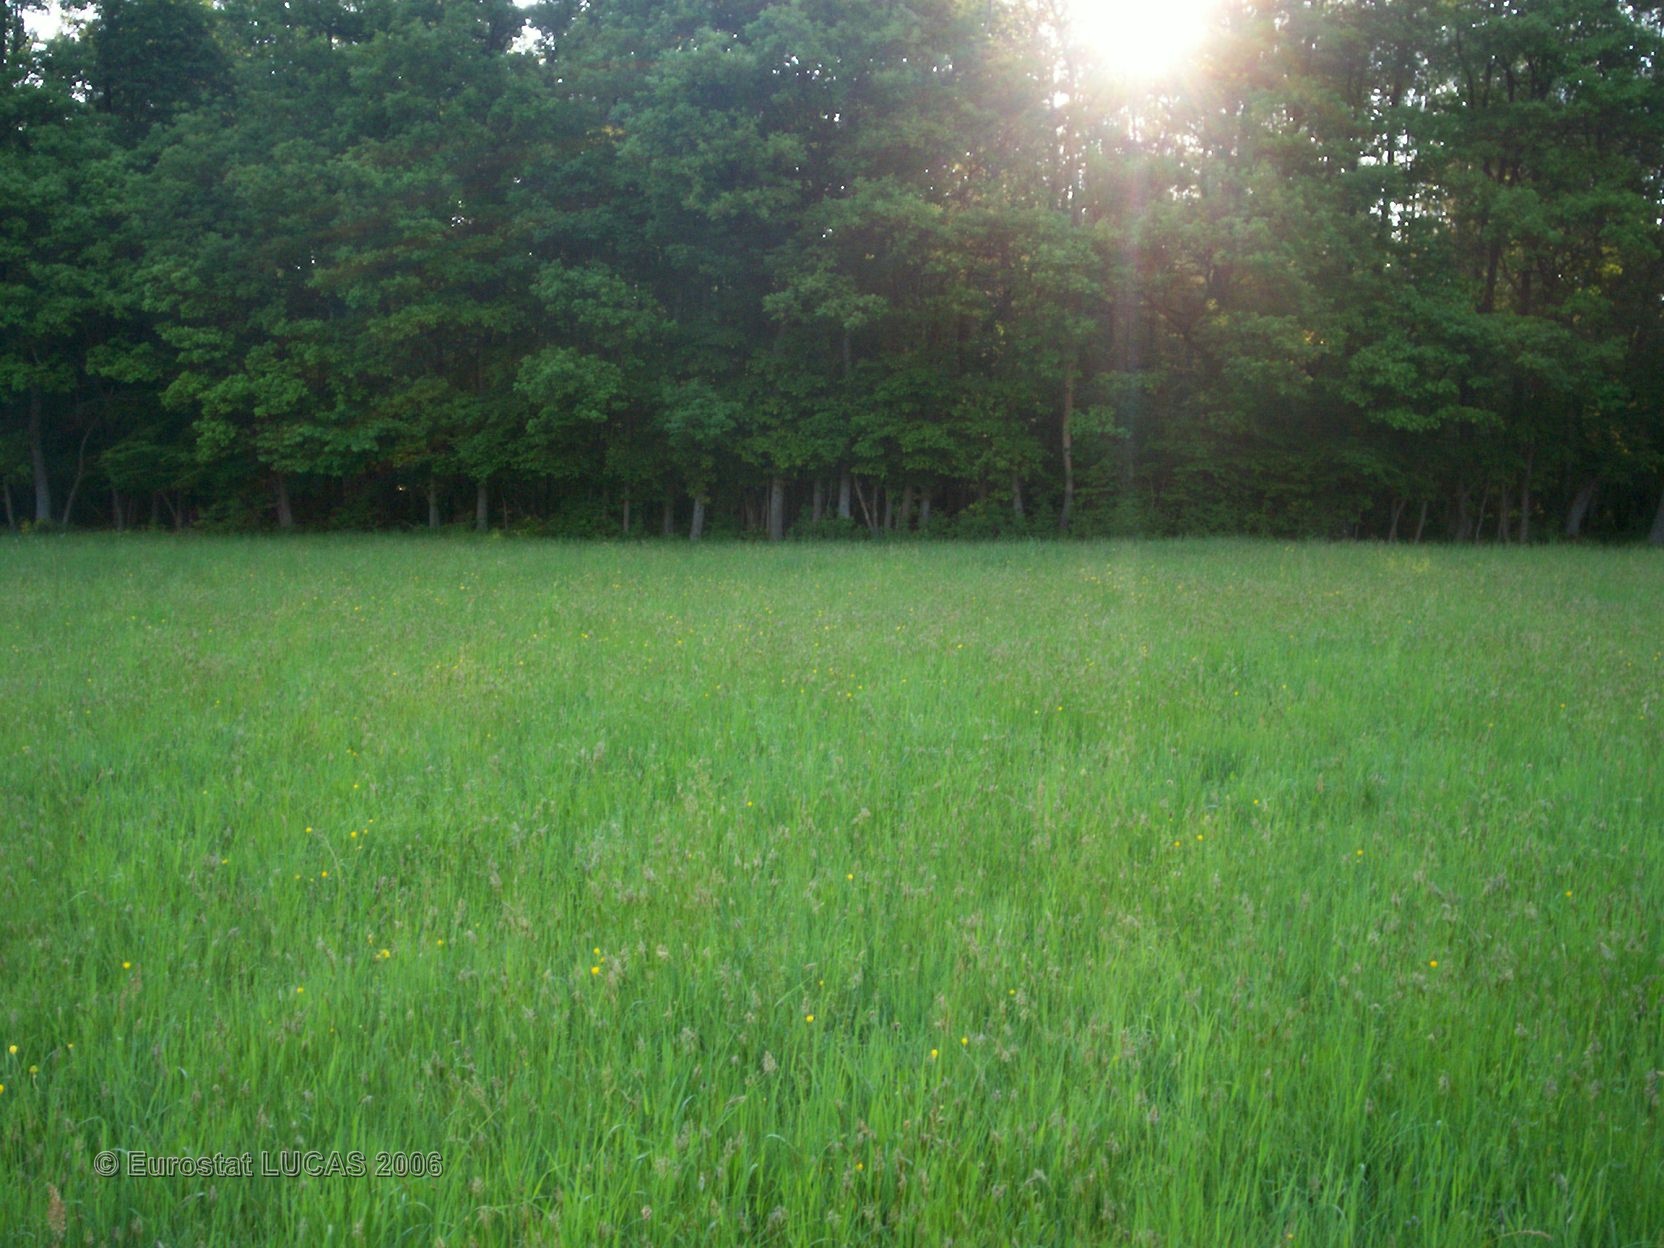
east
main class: Grassland
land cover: Grassland without tree/shrub cover
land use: Agriculture (excluding fallow land and kitchen gardens)
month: May
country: FR
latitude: 48.6245
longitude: 7.3823
